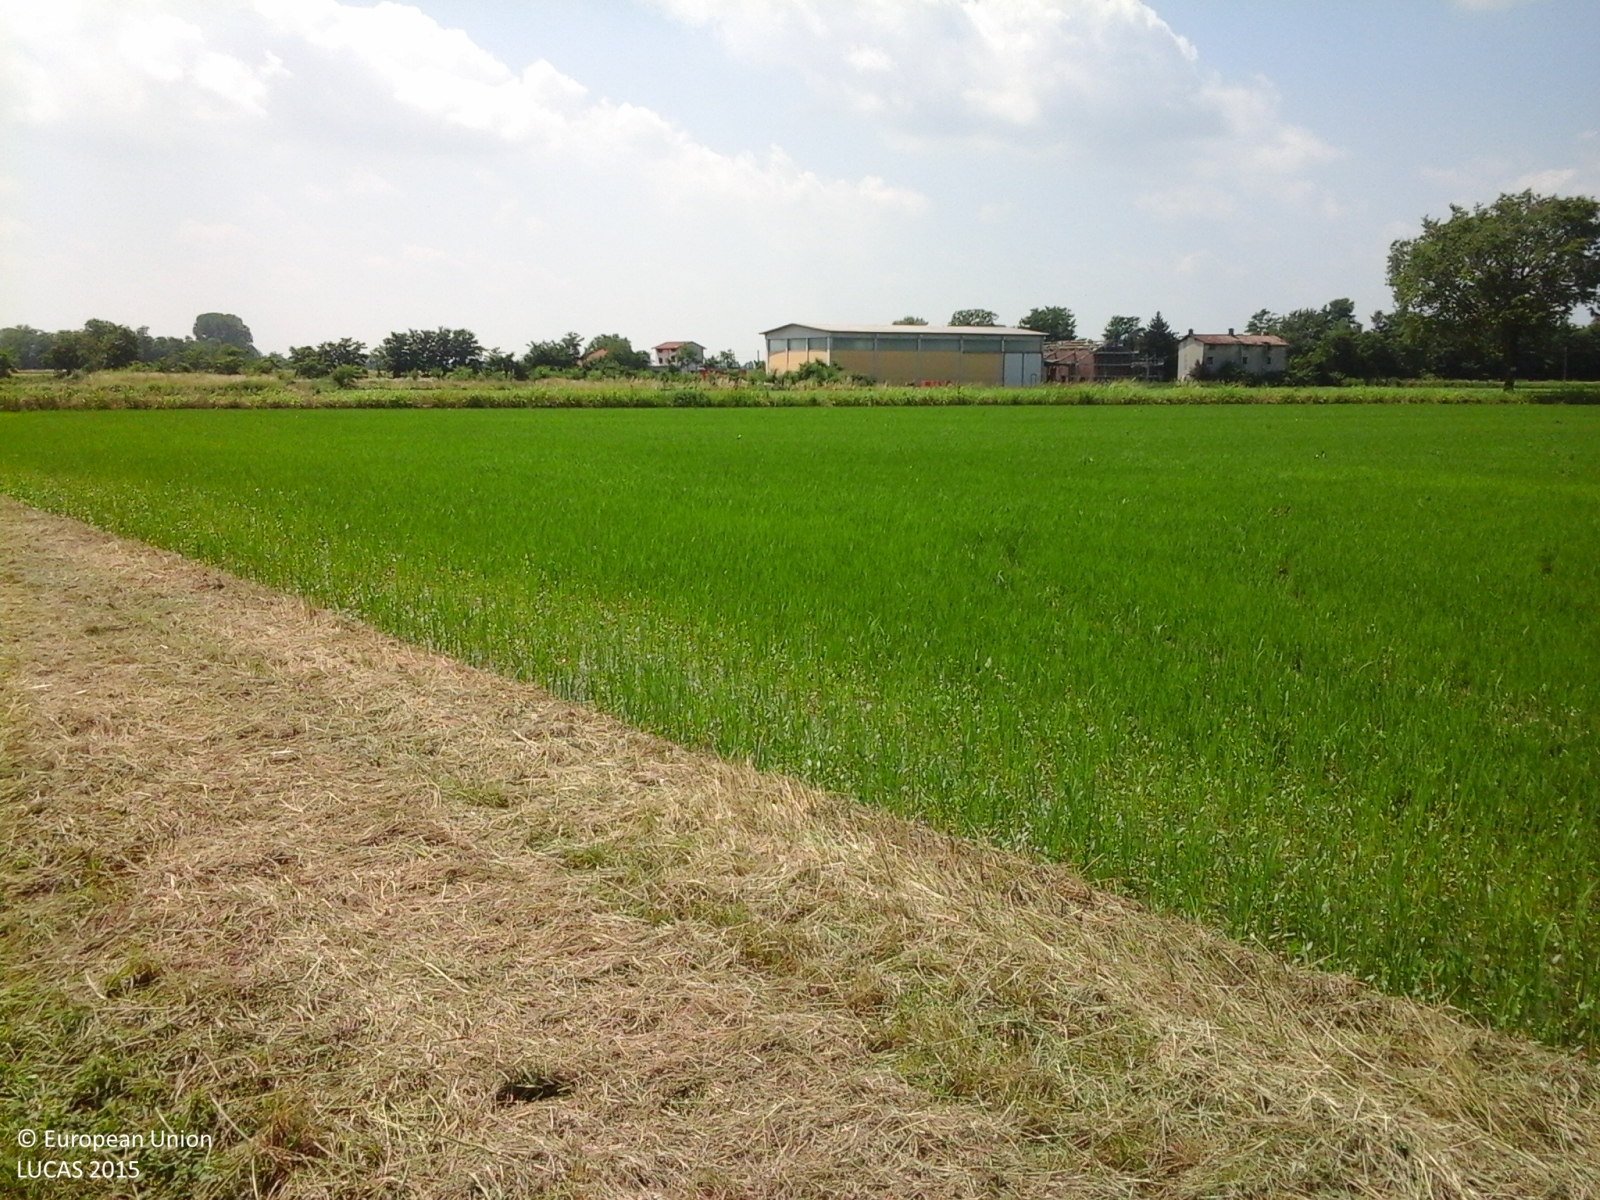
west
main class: Cropland
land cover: Rice
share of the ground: > 75 %
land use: Agriculture (excluding fallow land and kitchen gardens)
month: June
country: IT
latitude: 45.3533
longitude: 8.7895
